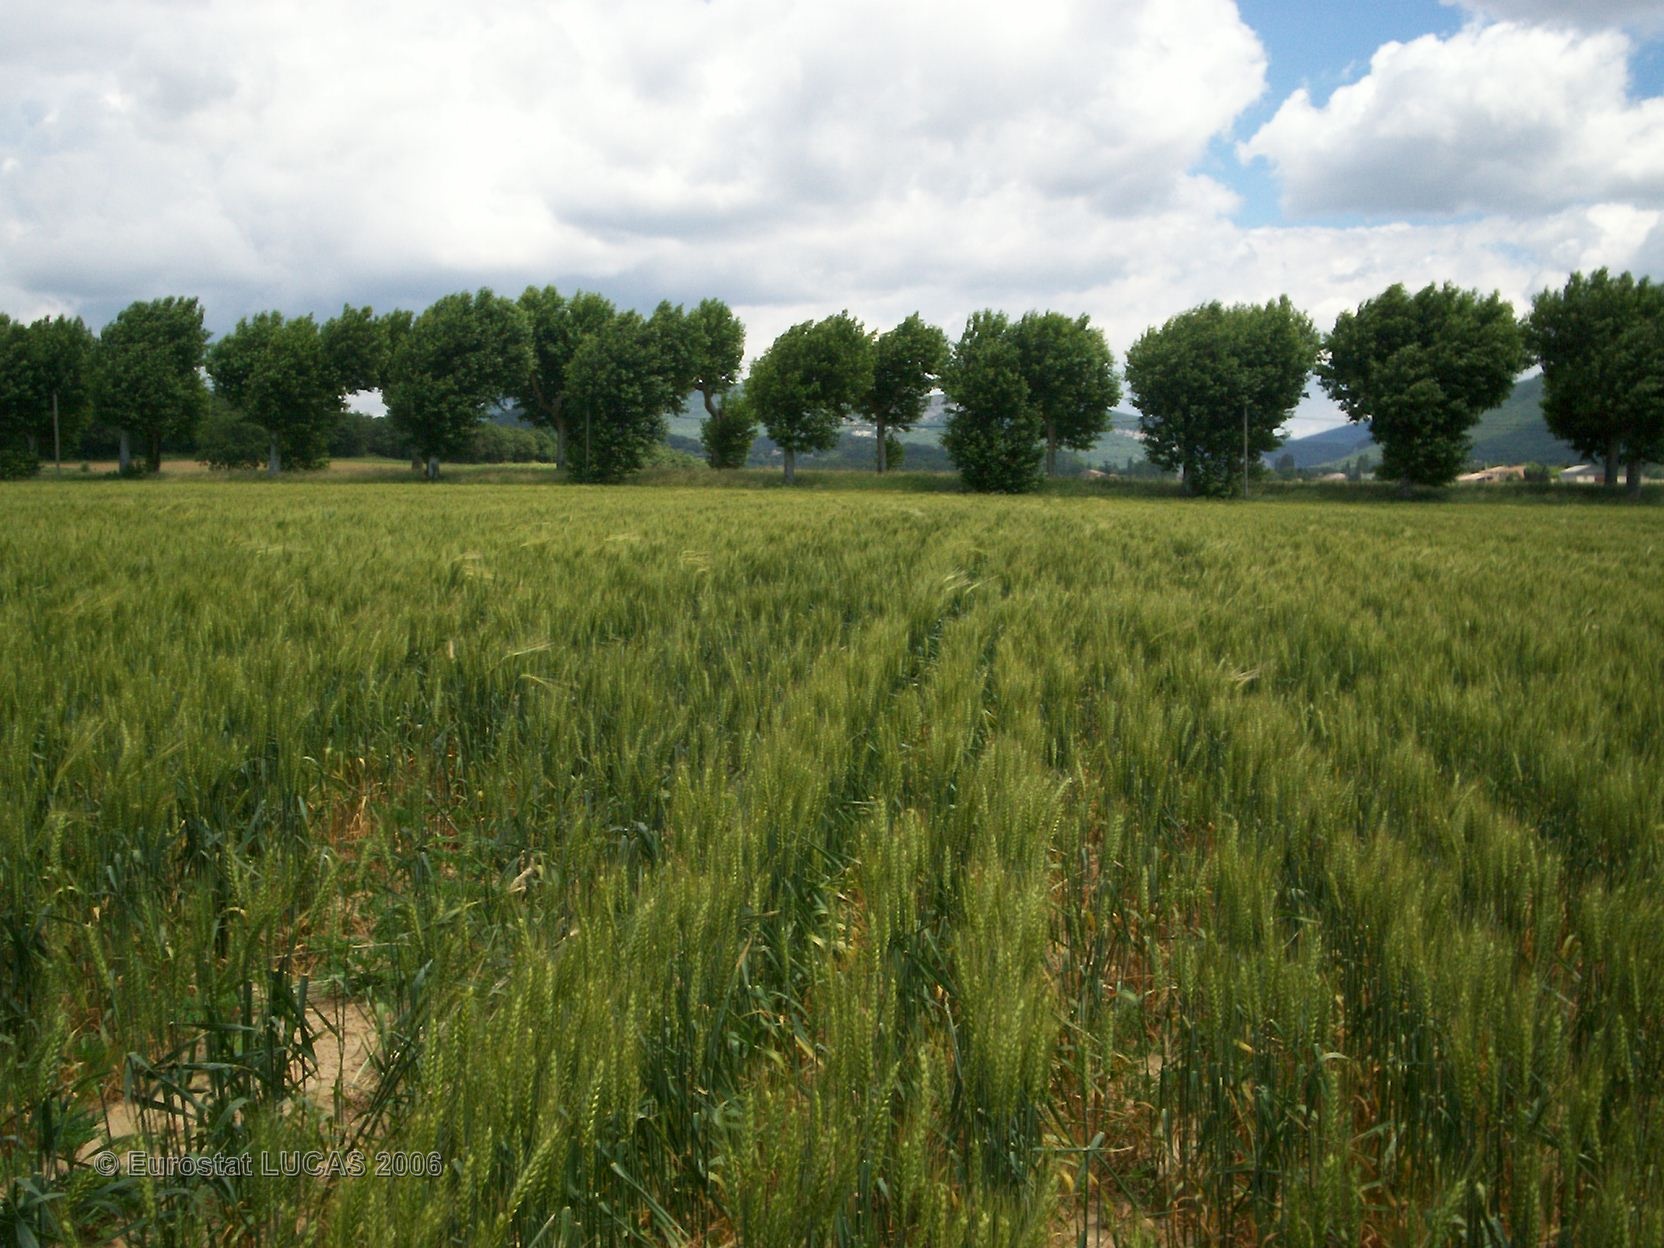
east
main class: Cropland
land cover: Durum wheat
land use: Agriculture (excluding fallow land and kitchen gardens)
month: May
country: FR
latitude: 44.5508
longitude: 4.9087
